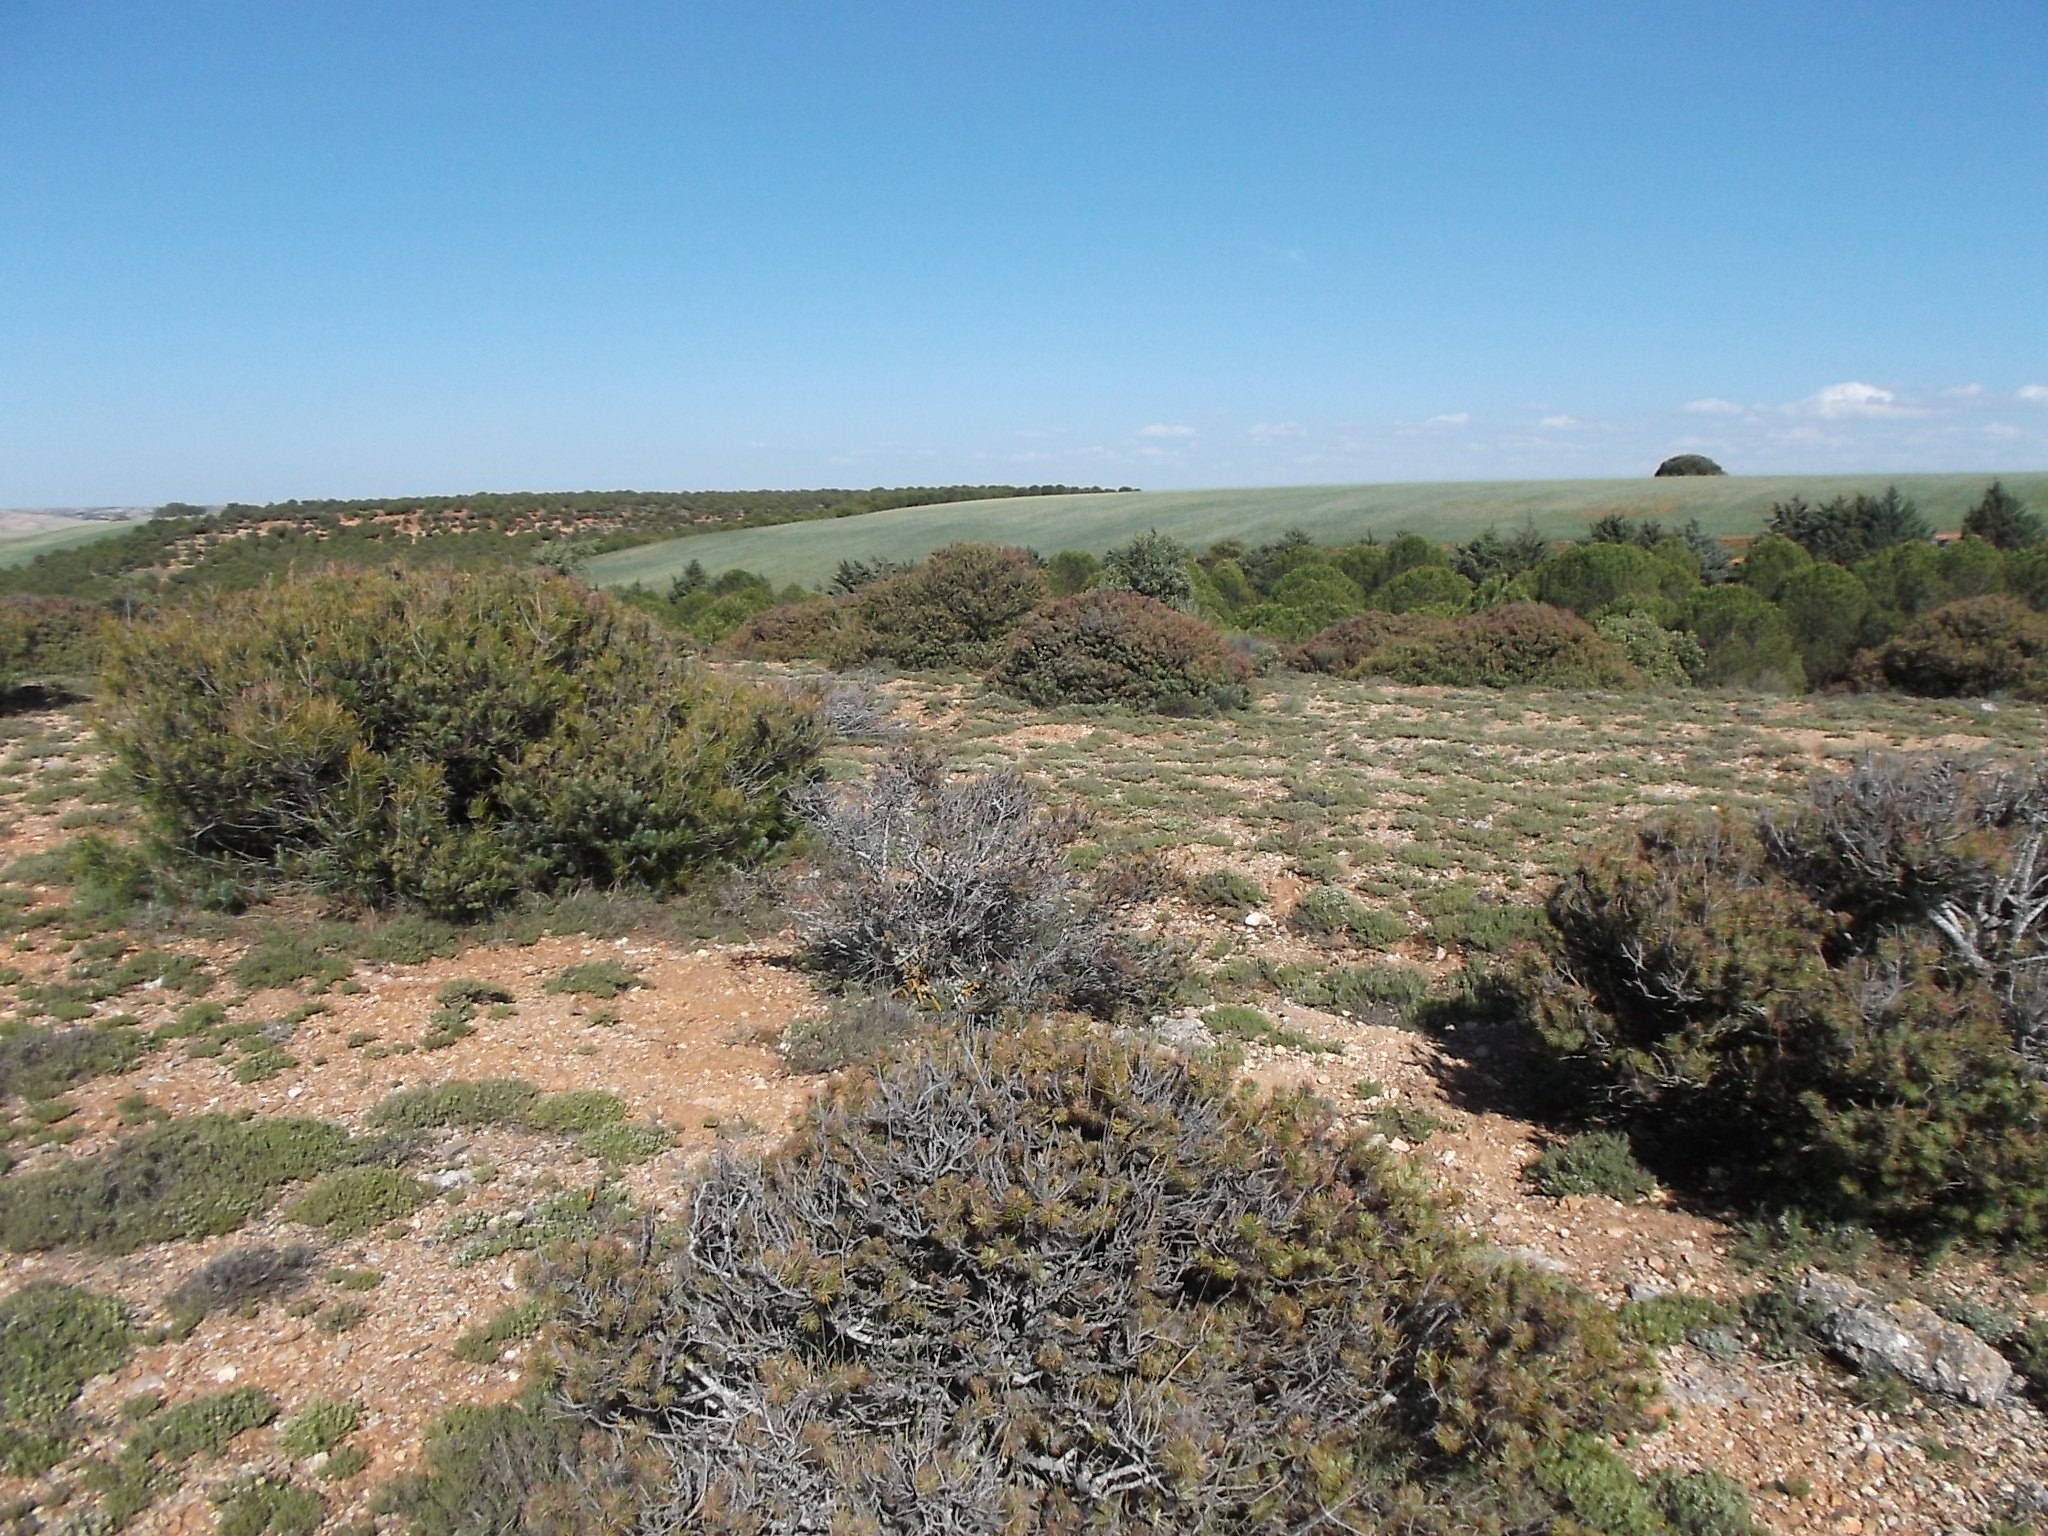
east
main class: Woodland
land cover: Pine dominated mixed woodland
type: coniferous forest of the mediterranean region
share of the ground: 25 - 50 %
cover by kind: herbaceous plants 35 %, coniferous forest trees 25 %, unconsolidated bare surface 20 %, broadleaved forest trees 10 %, shrubs 10 %
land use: Forestry
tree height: < 5 m
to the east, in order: Pine dominated mixed woodland; Tracks; Grass margins; Common wheat
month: May
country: ES
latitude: 41.2109
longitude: -5.4013
